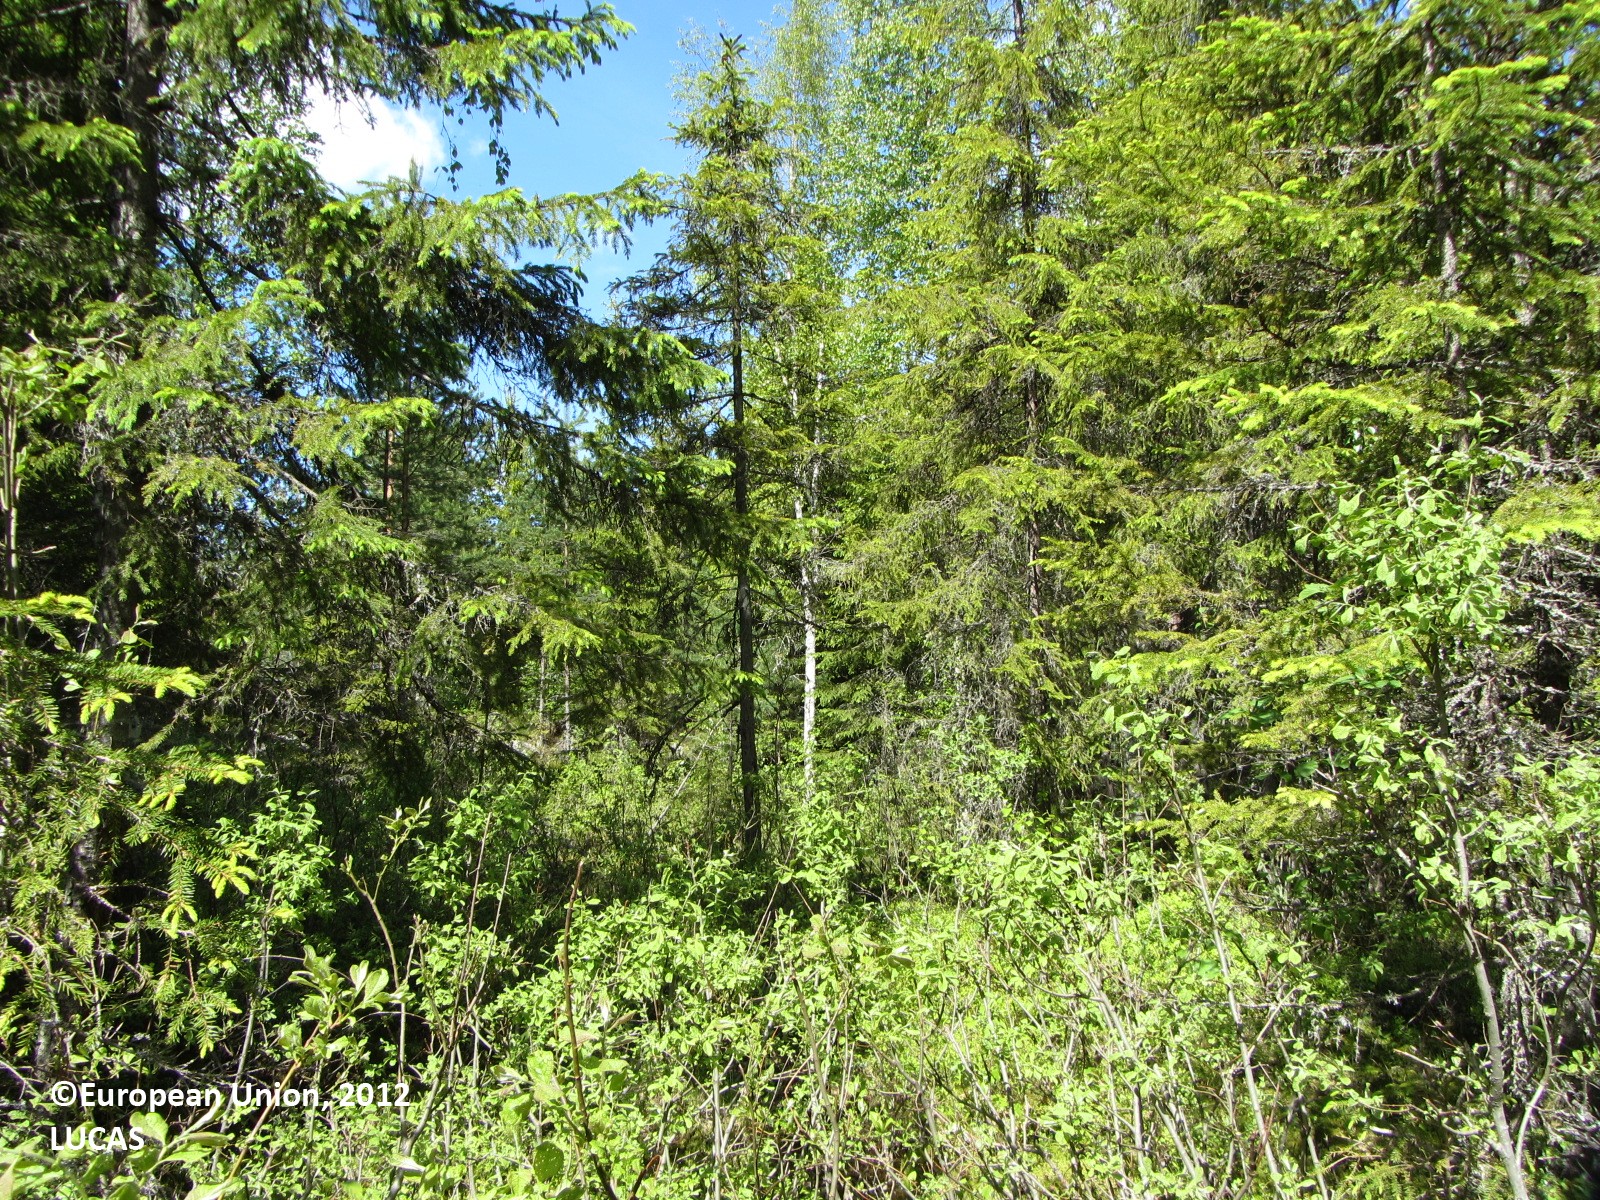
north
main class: Woodland
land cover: Spruce dominated mixed woodland
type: boreal forest
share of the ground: > 75 %
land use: Forestry
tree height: > 5 m
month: June
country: FI
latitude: 61.6754
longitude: 25.1309
